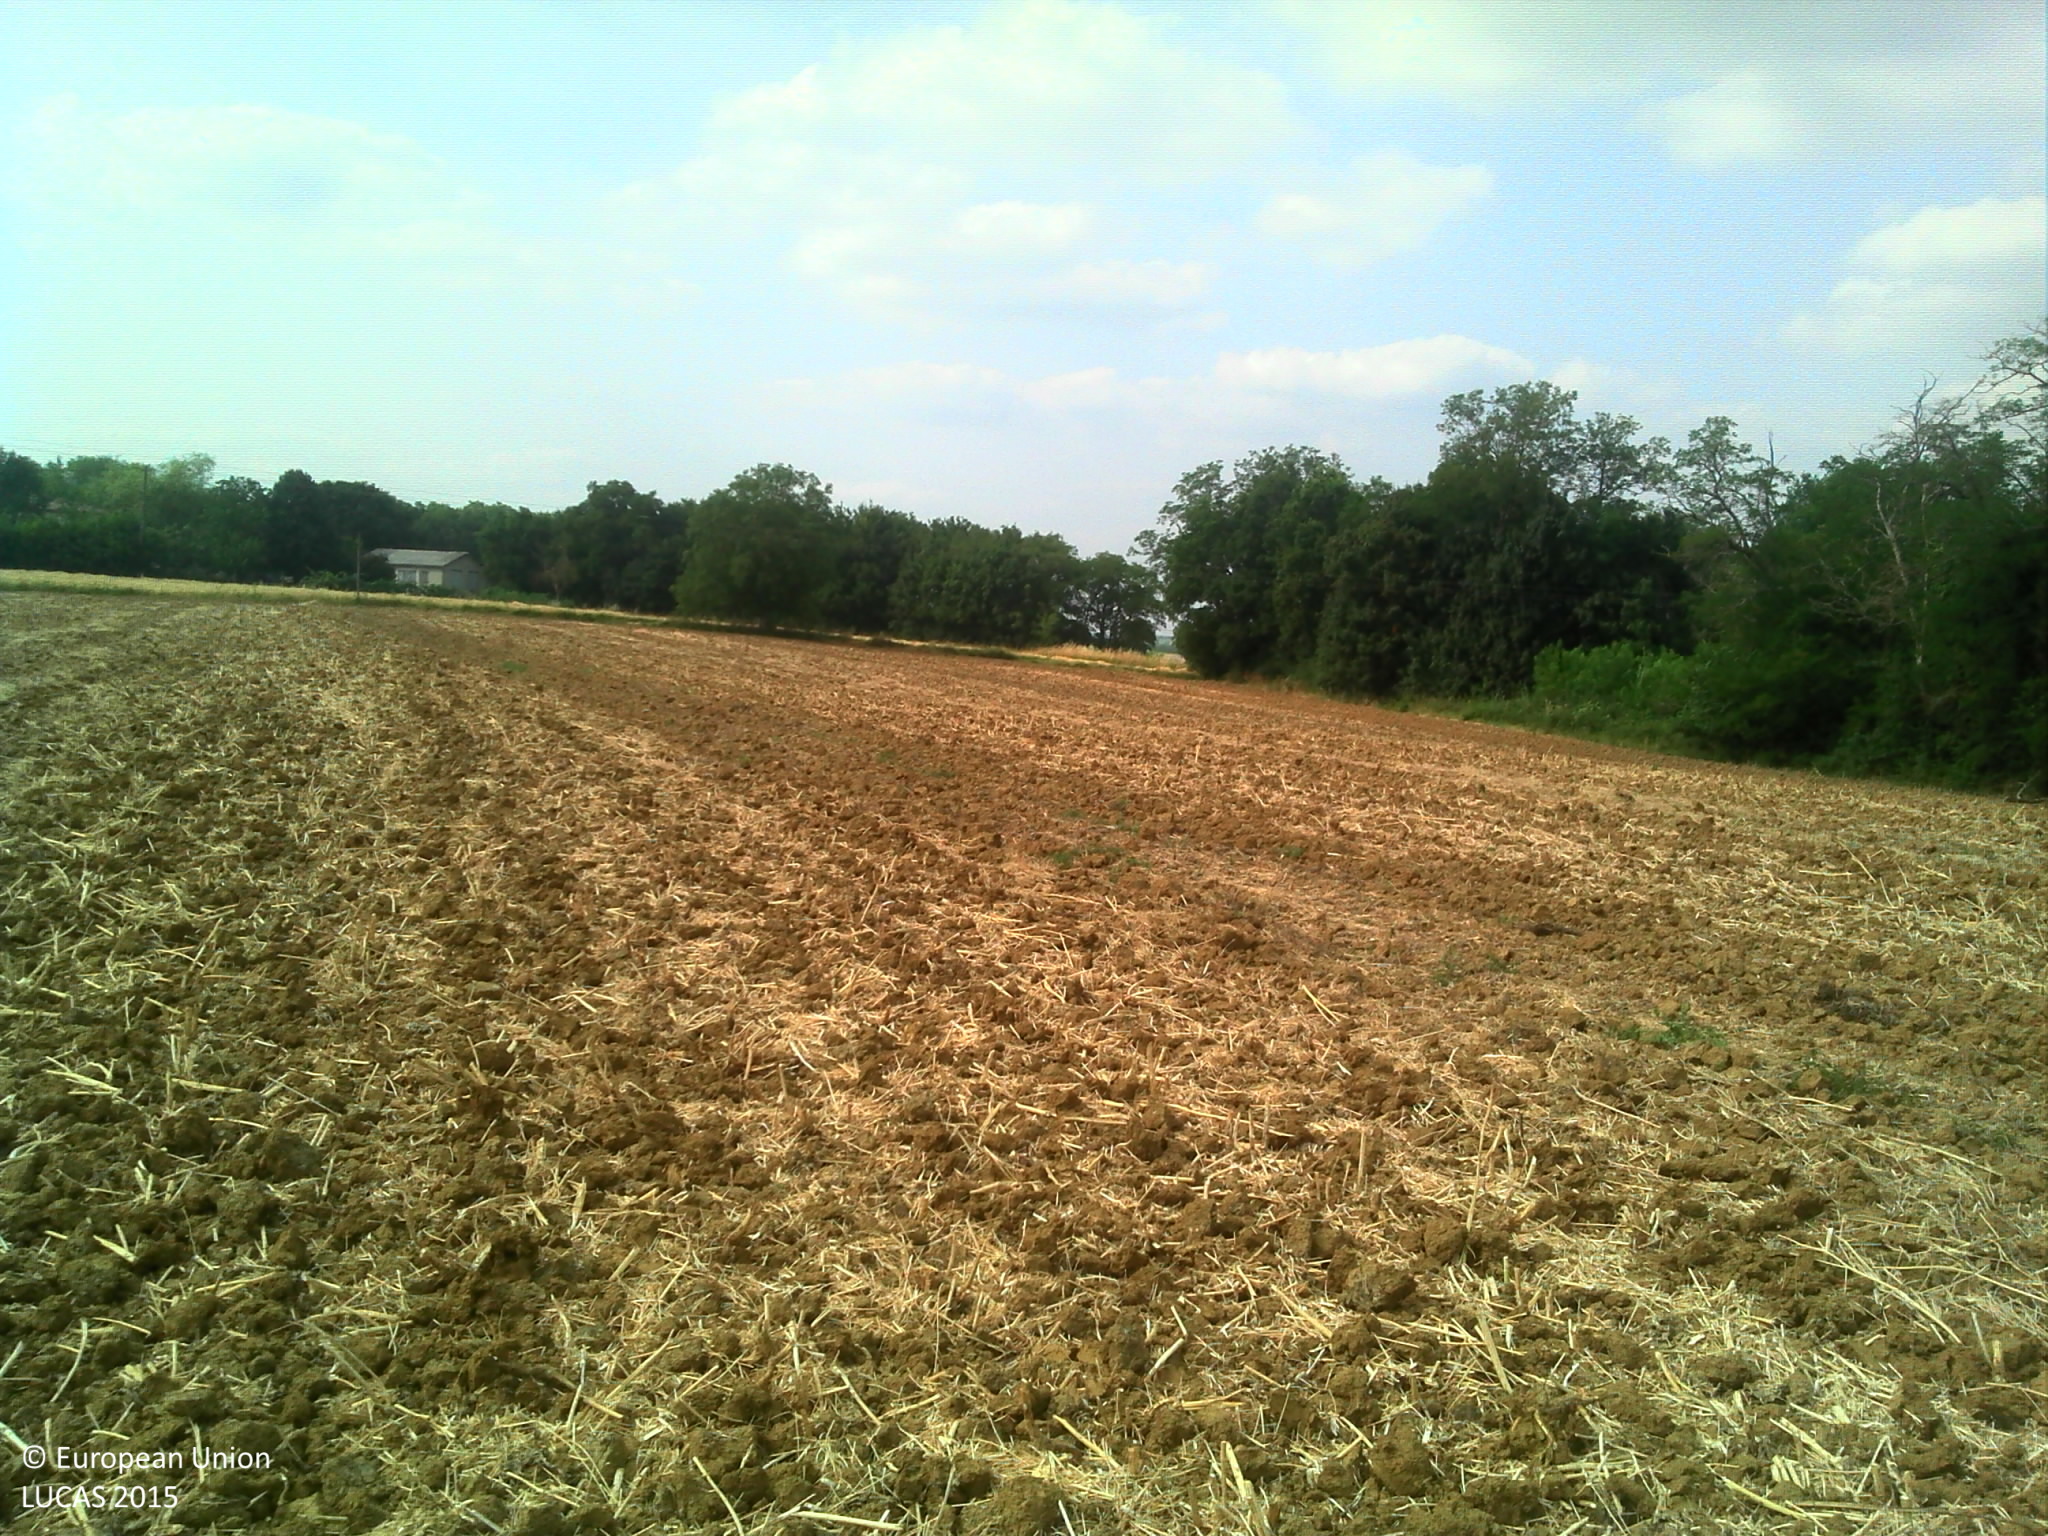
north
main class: Cropland
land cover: Rape and turnip rape
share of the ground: 10 - 25 %
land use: Agriculture (excluding fallow land and kitchen gardens)
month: July
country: FR
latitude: 44.2619
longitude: 0.9400
